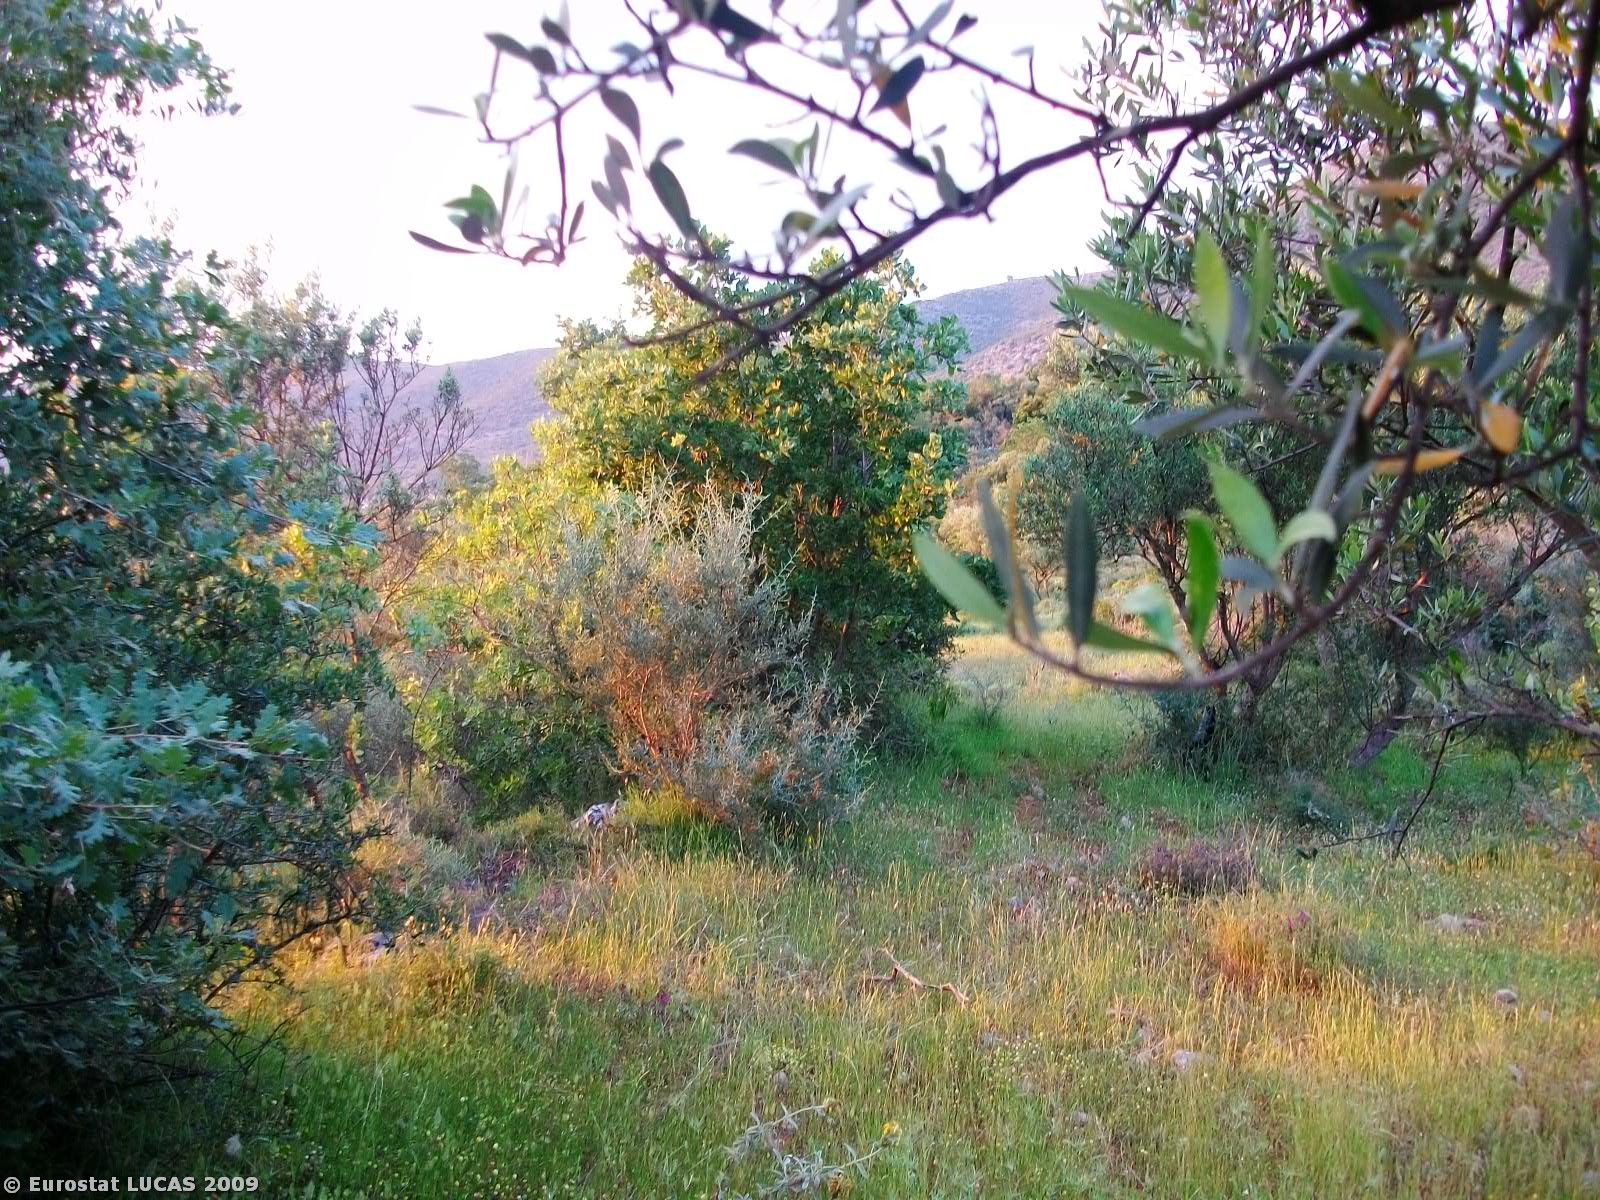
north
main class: Cropland
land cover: Olive groves
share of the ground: 50 - 75 %
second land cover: Grassland with sparse tree/shrub cover
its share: 50 - 75 %
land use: Agriculture (excluding fallow land and kitchen gardens)
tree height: < 5 m
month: May
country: GR
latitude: 37.1838
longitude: 22.0190
